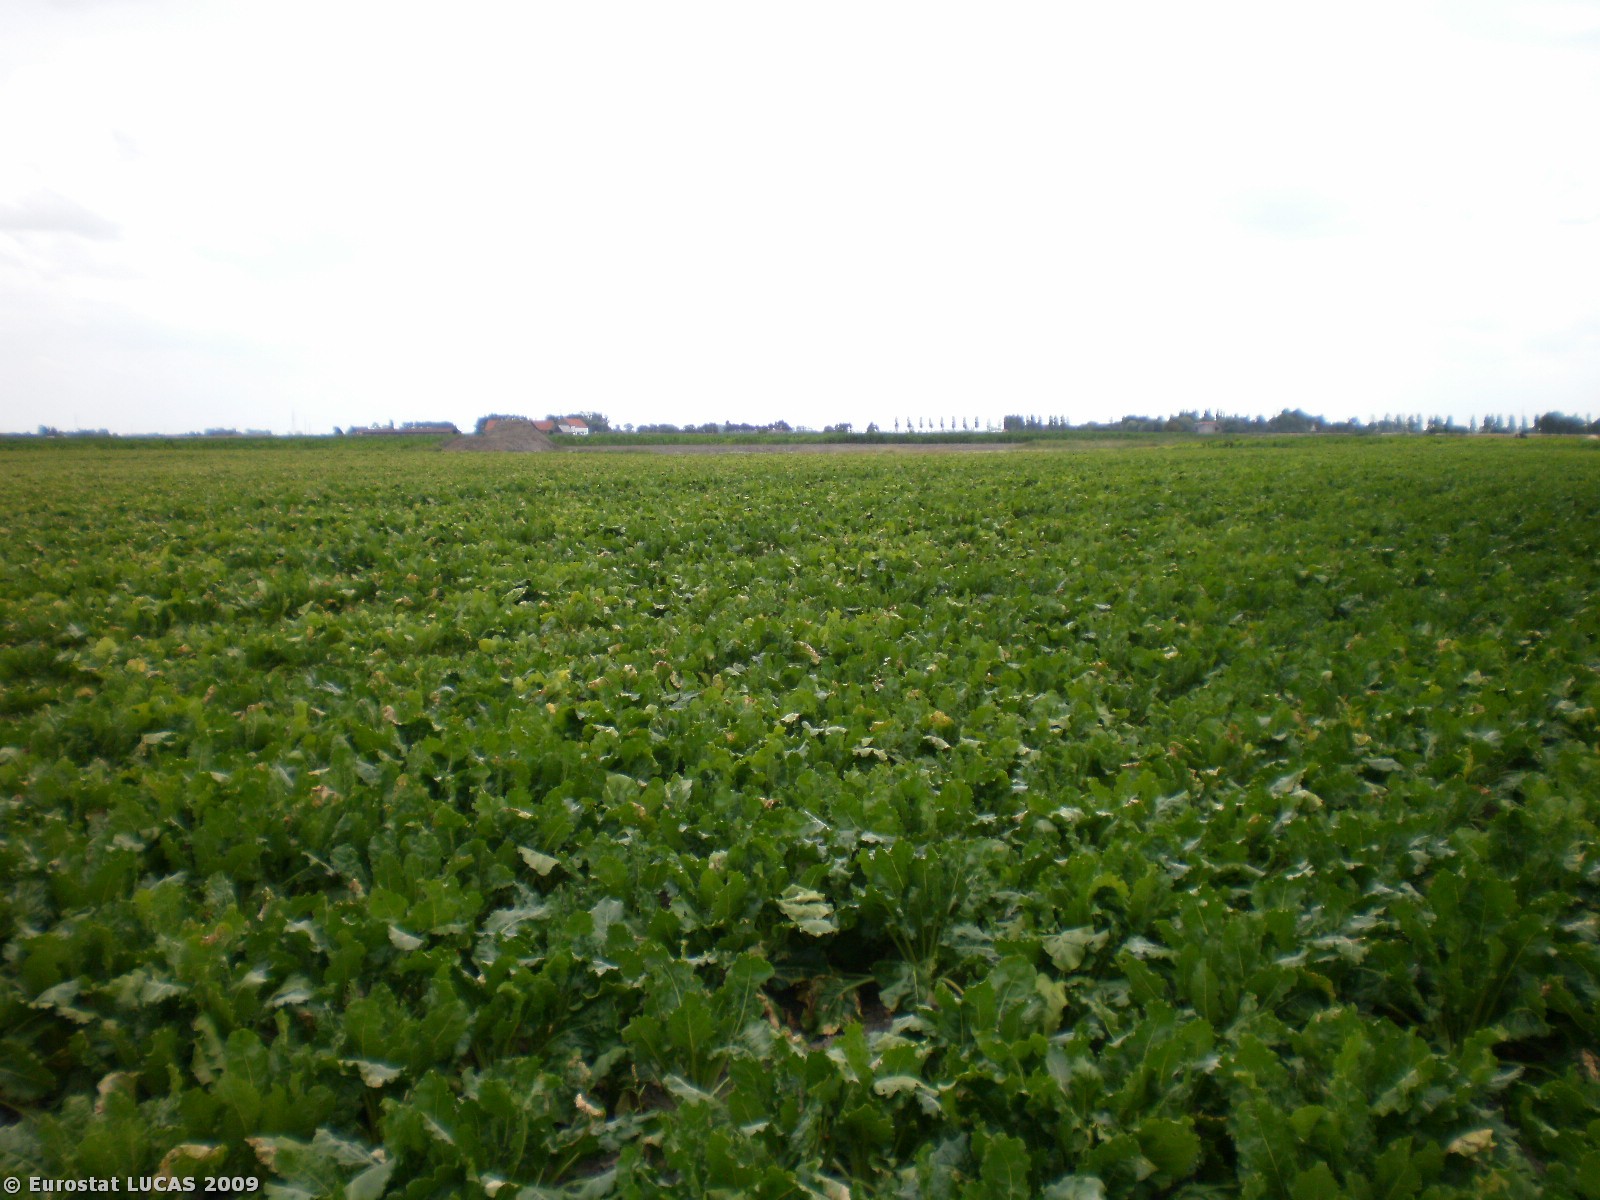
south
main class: Cropland
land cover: Sugar beet
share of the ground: 50 - 75 %
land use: Agriculture (excluding fallow land and kitchen gardens)
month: July
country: BE
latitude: 51.1103
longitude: 2.7754
